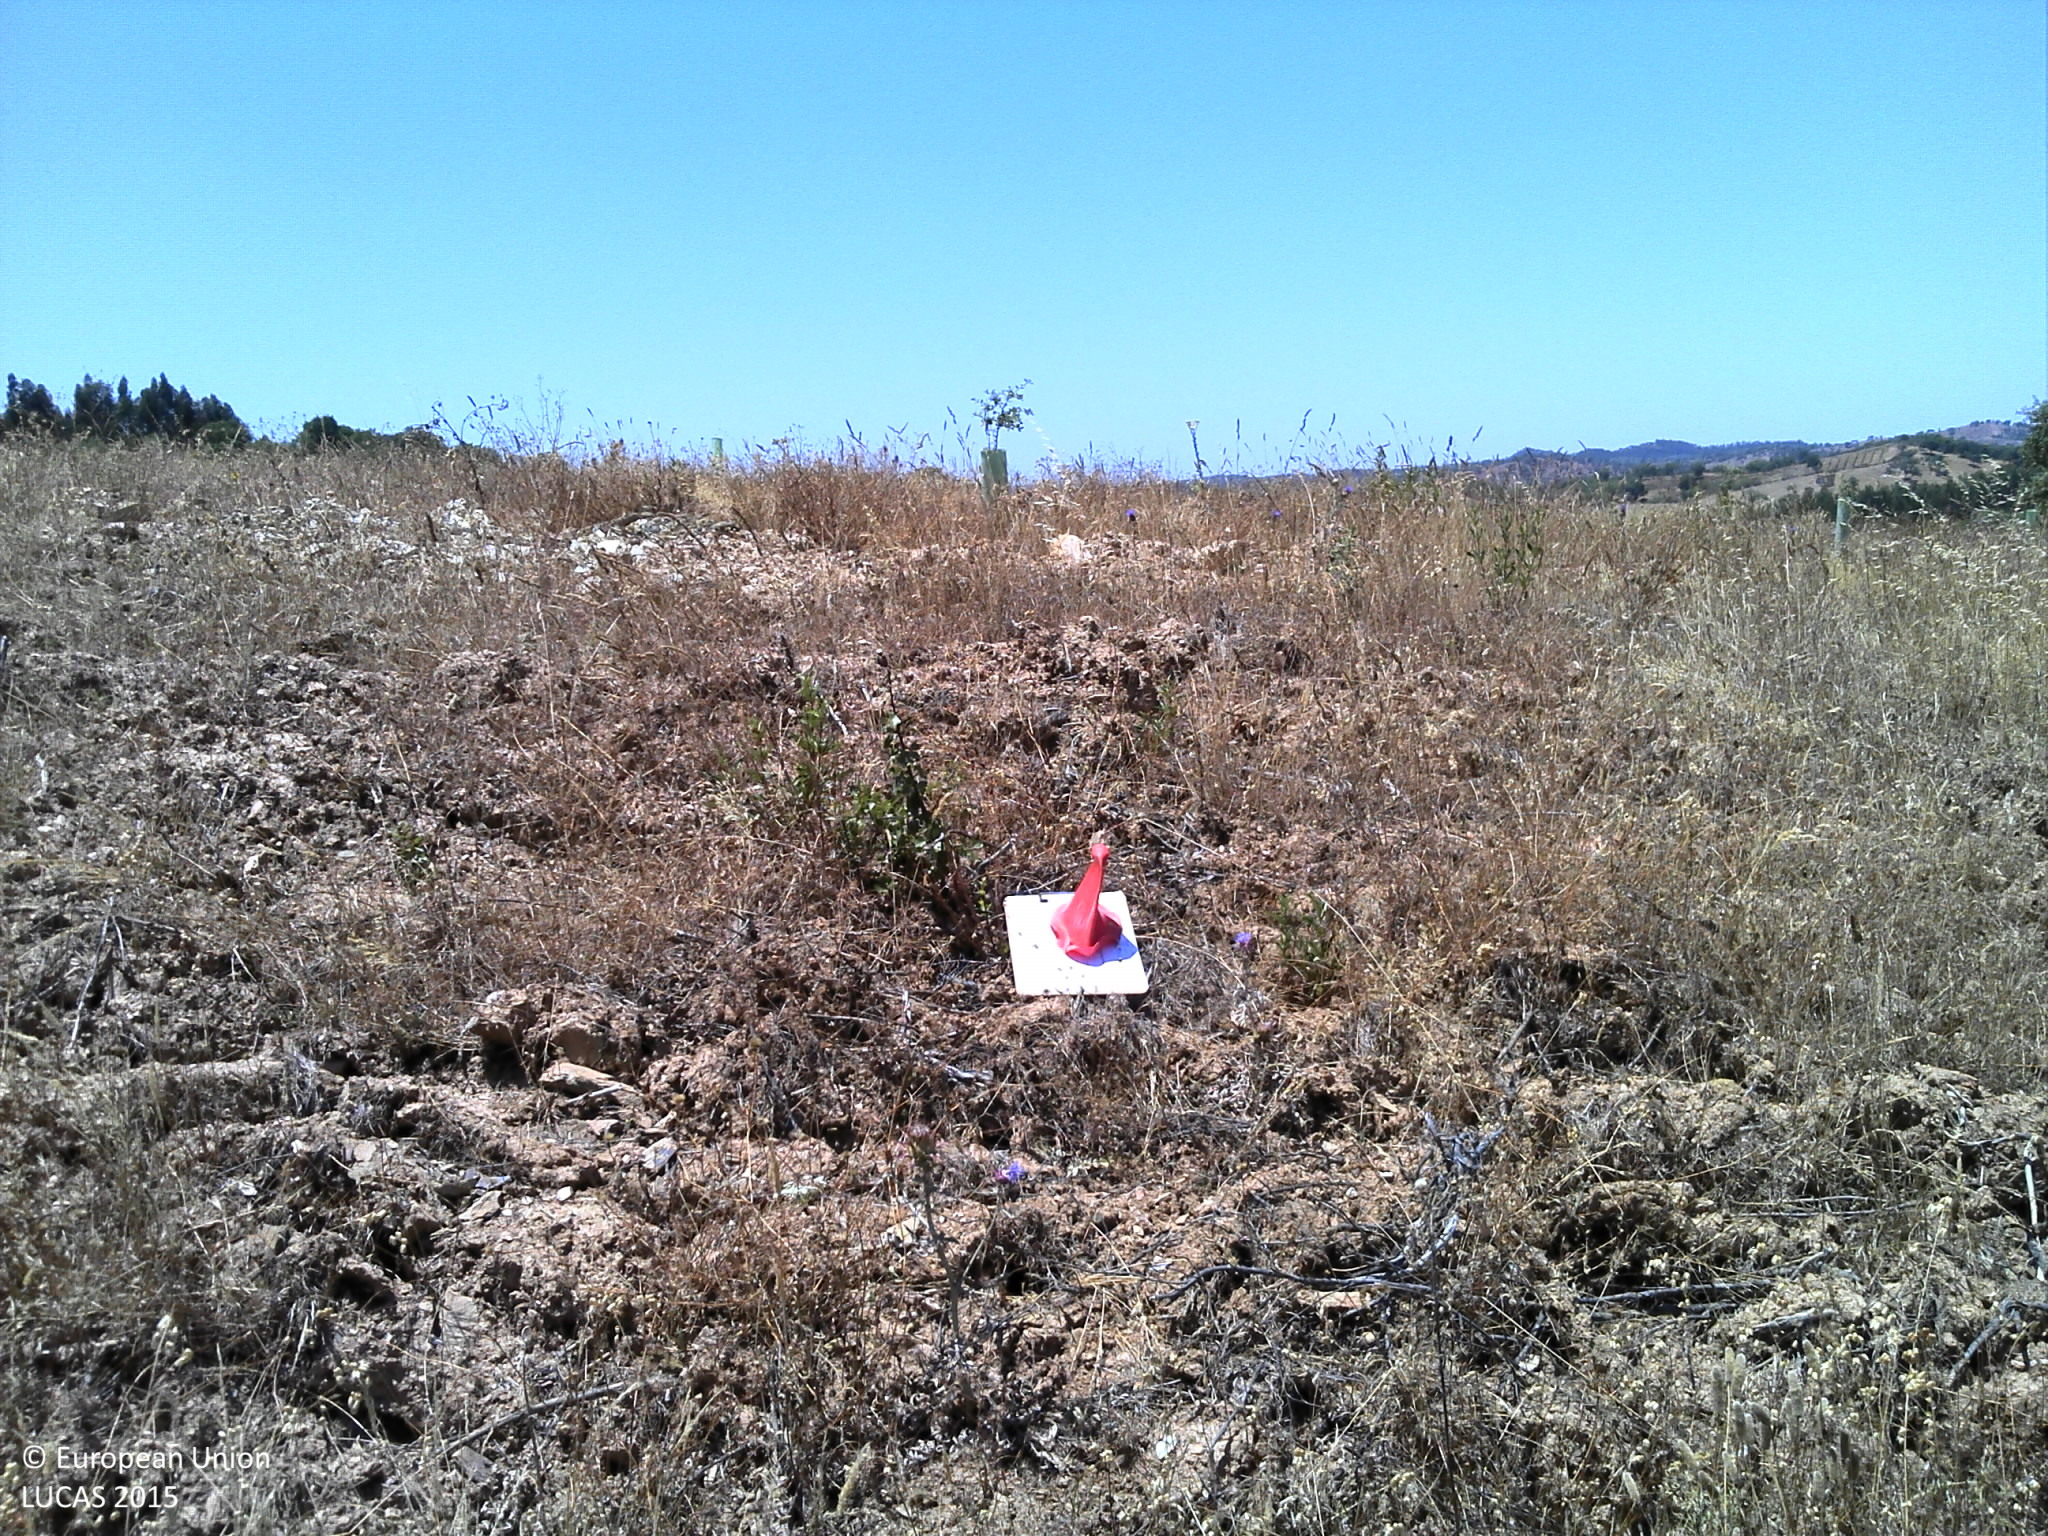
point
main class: Grassland
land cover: Grassland with sparse tree/shrub cover
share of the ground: 25 - 50 %
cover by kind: herbaceous plants 50 %, unconsolidated bare surface 45 %, broadleaved forest trees 5 %
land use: Forestry
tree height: < 5 m
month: June
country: PT
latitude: 37.7141
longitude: -8.4936
